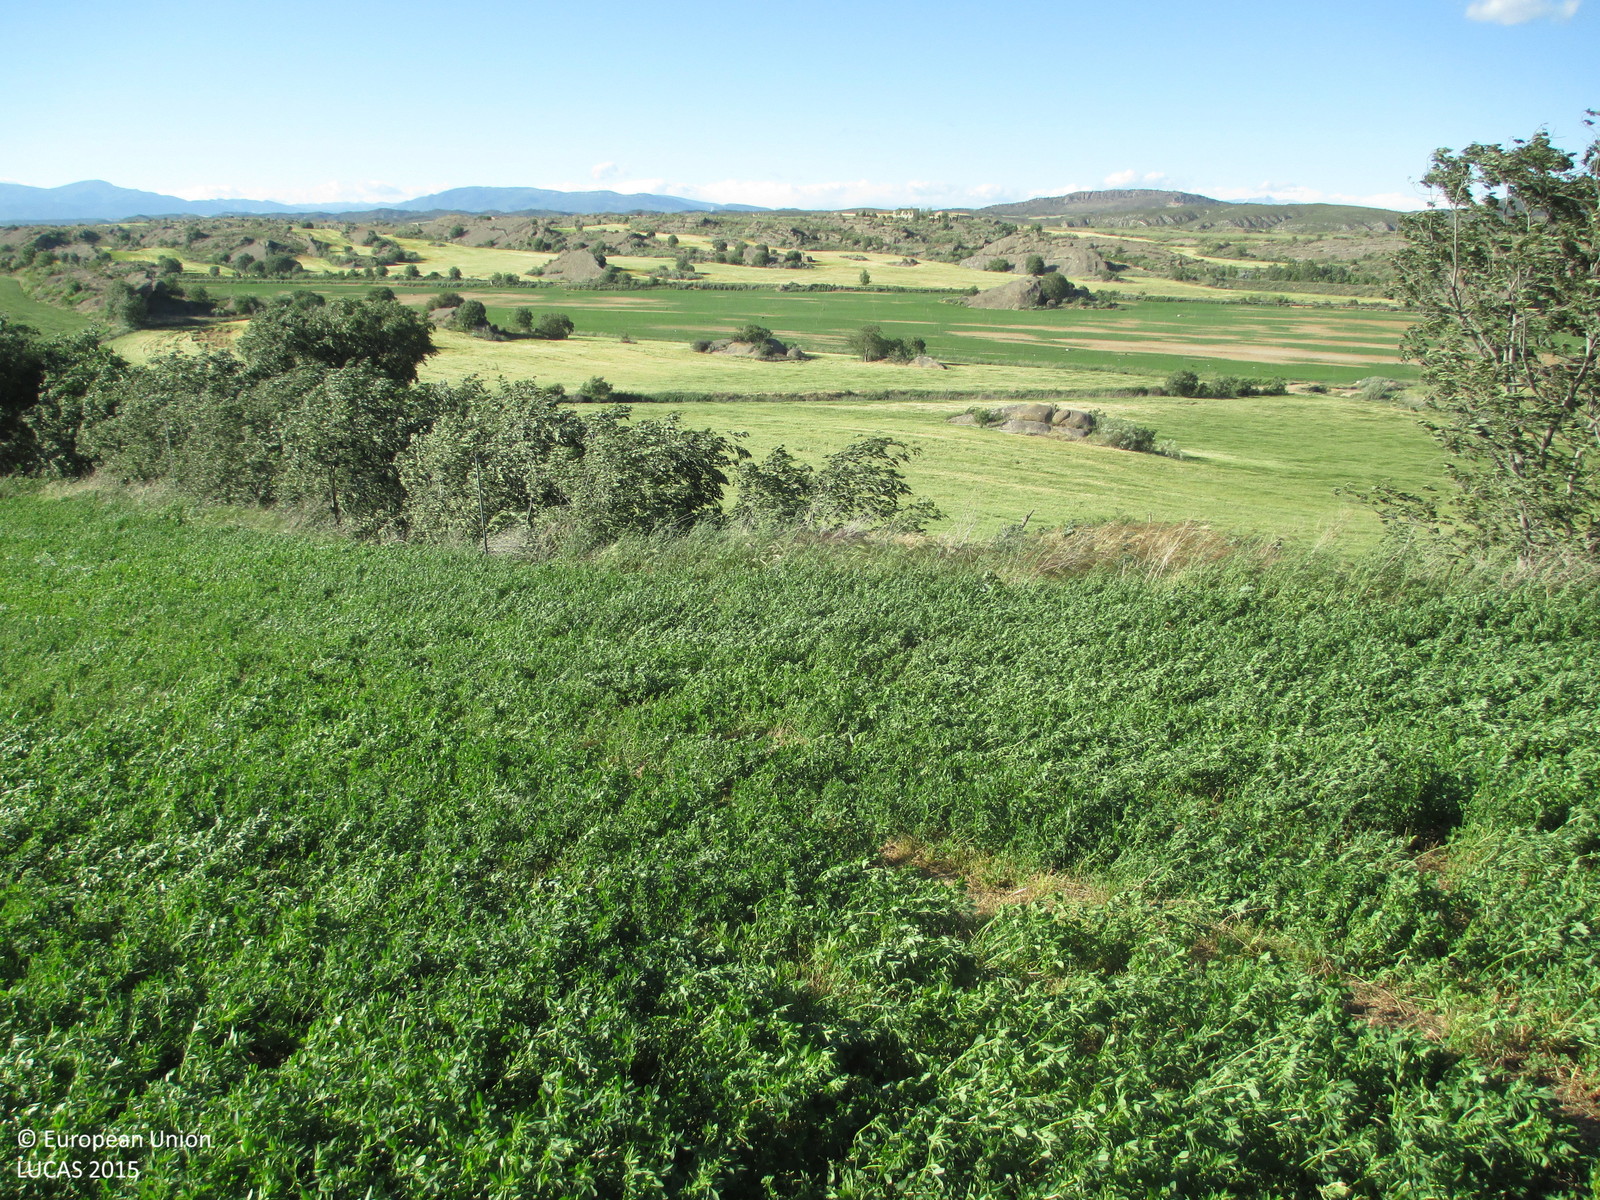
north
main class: Cropland
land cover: Lucerne
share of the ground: > 75 %
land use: Agriculture (excluding fallow land and kitchen gardens)
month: May
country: ES
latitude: 41.9965
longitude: 0.0219
